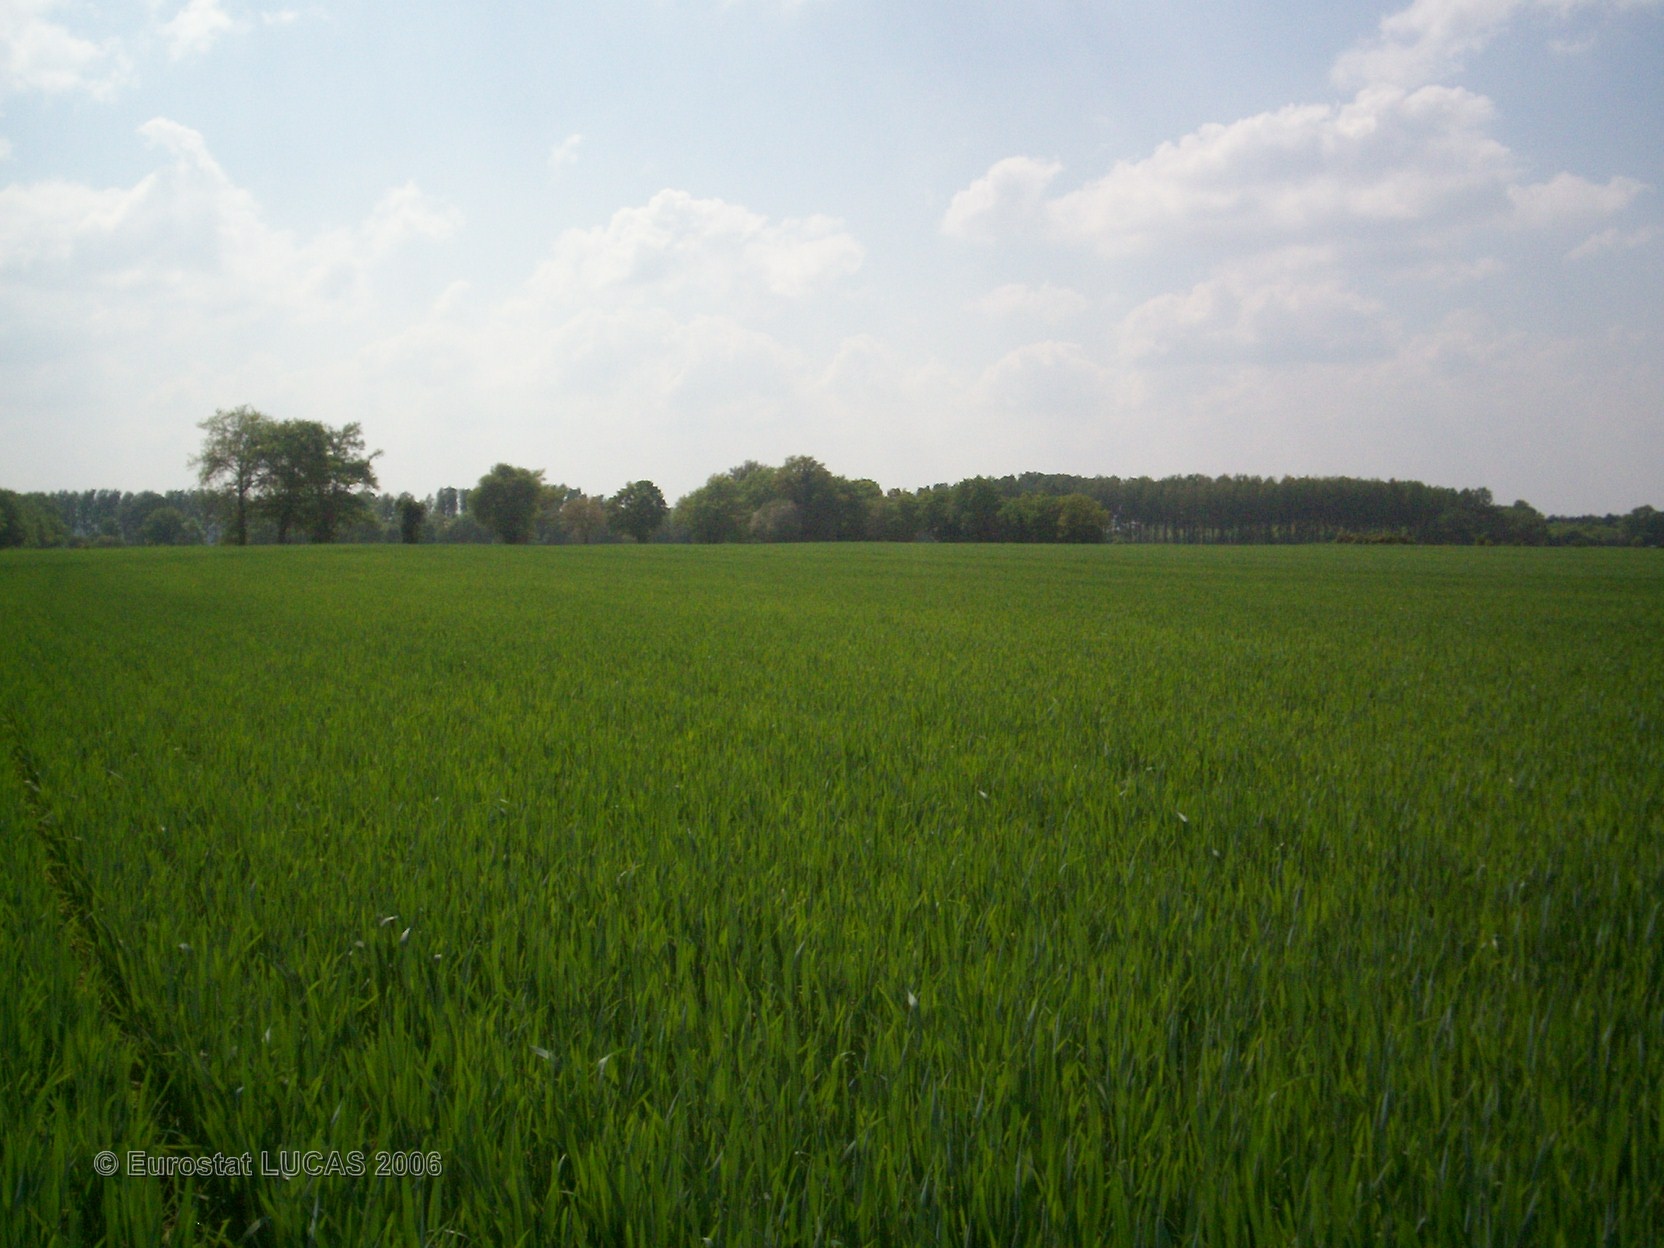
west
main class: Cropland
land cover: Common wheat
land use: Agriculture (excluding fallow land and kitchen gardens)
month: May
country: FR
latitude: 47.6580
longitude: 0.1886
